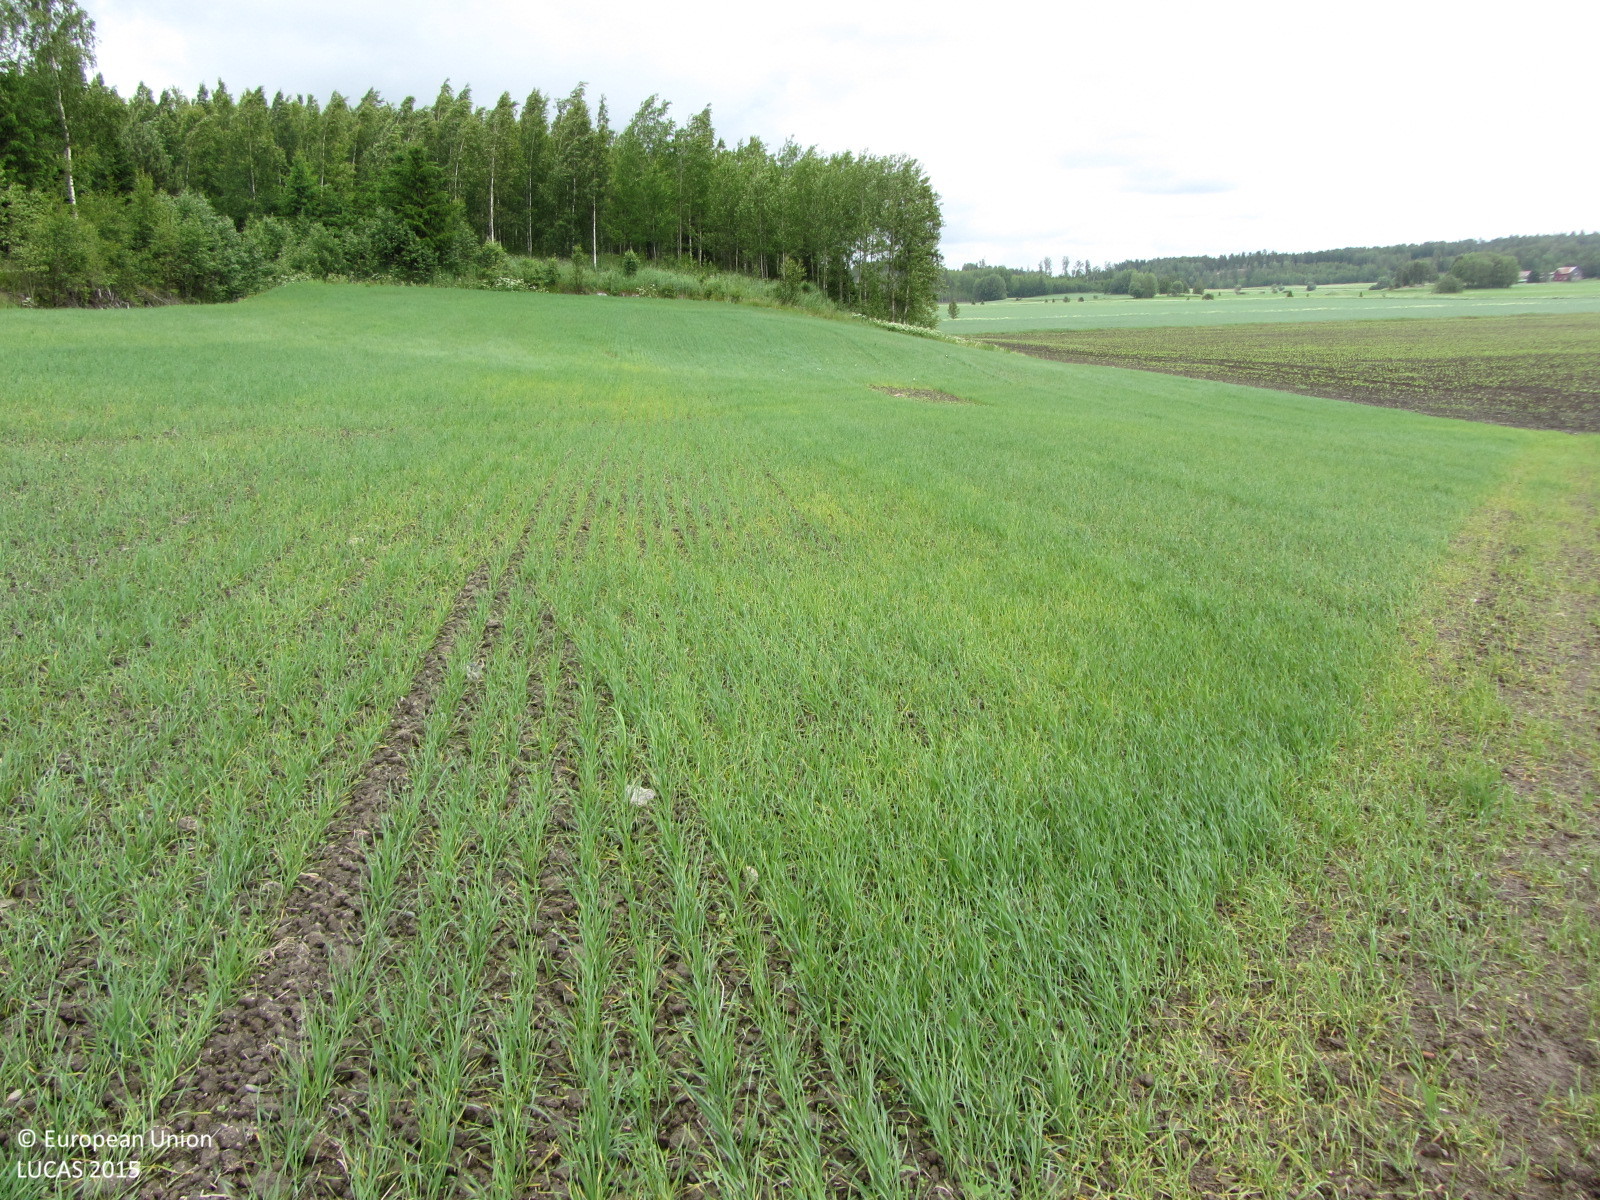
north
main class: Cropland
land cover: Common wheat
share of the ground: > 75 %
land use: Agriculture (excluding fallow land and kitchen gardens)
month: June
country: FI
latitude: 60.2501
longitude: 23.2179
